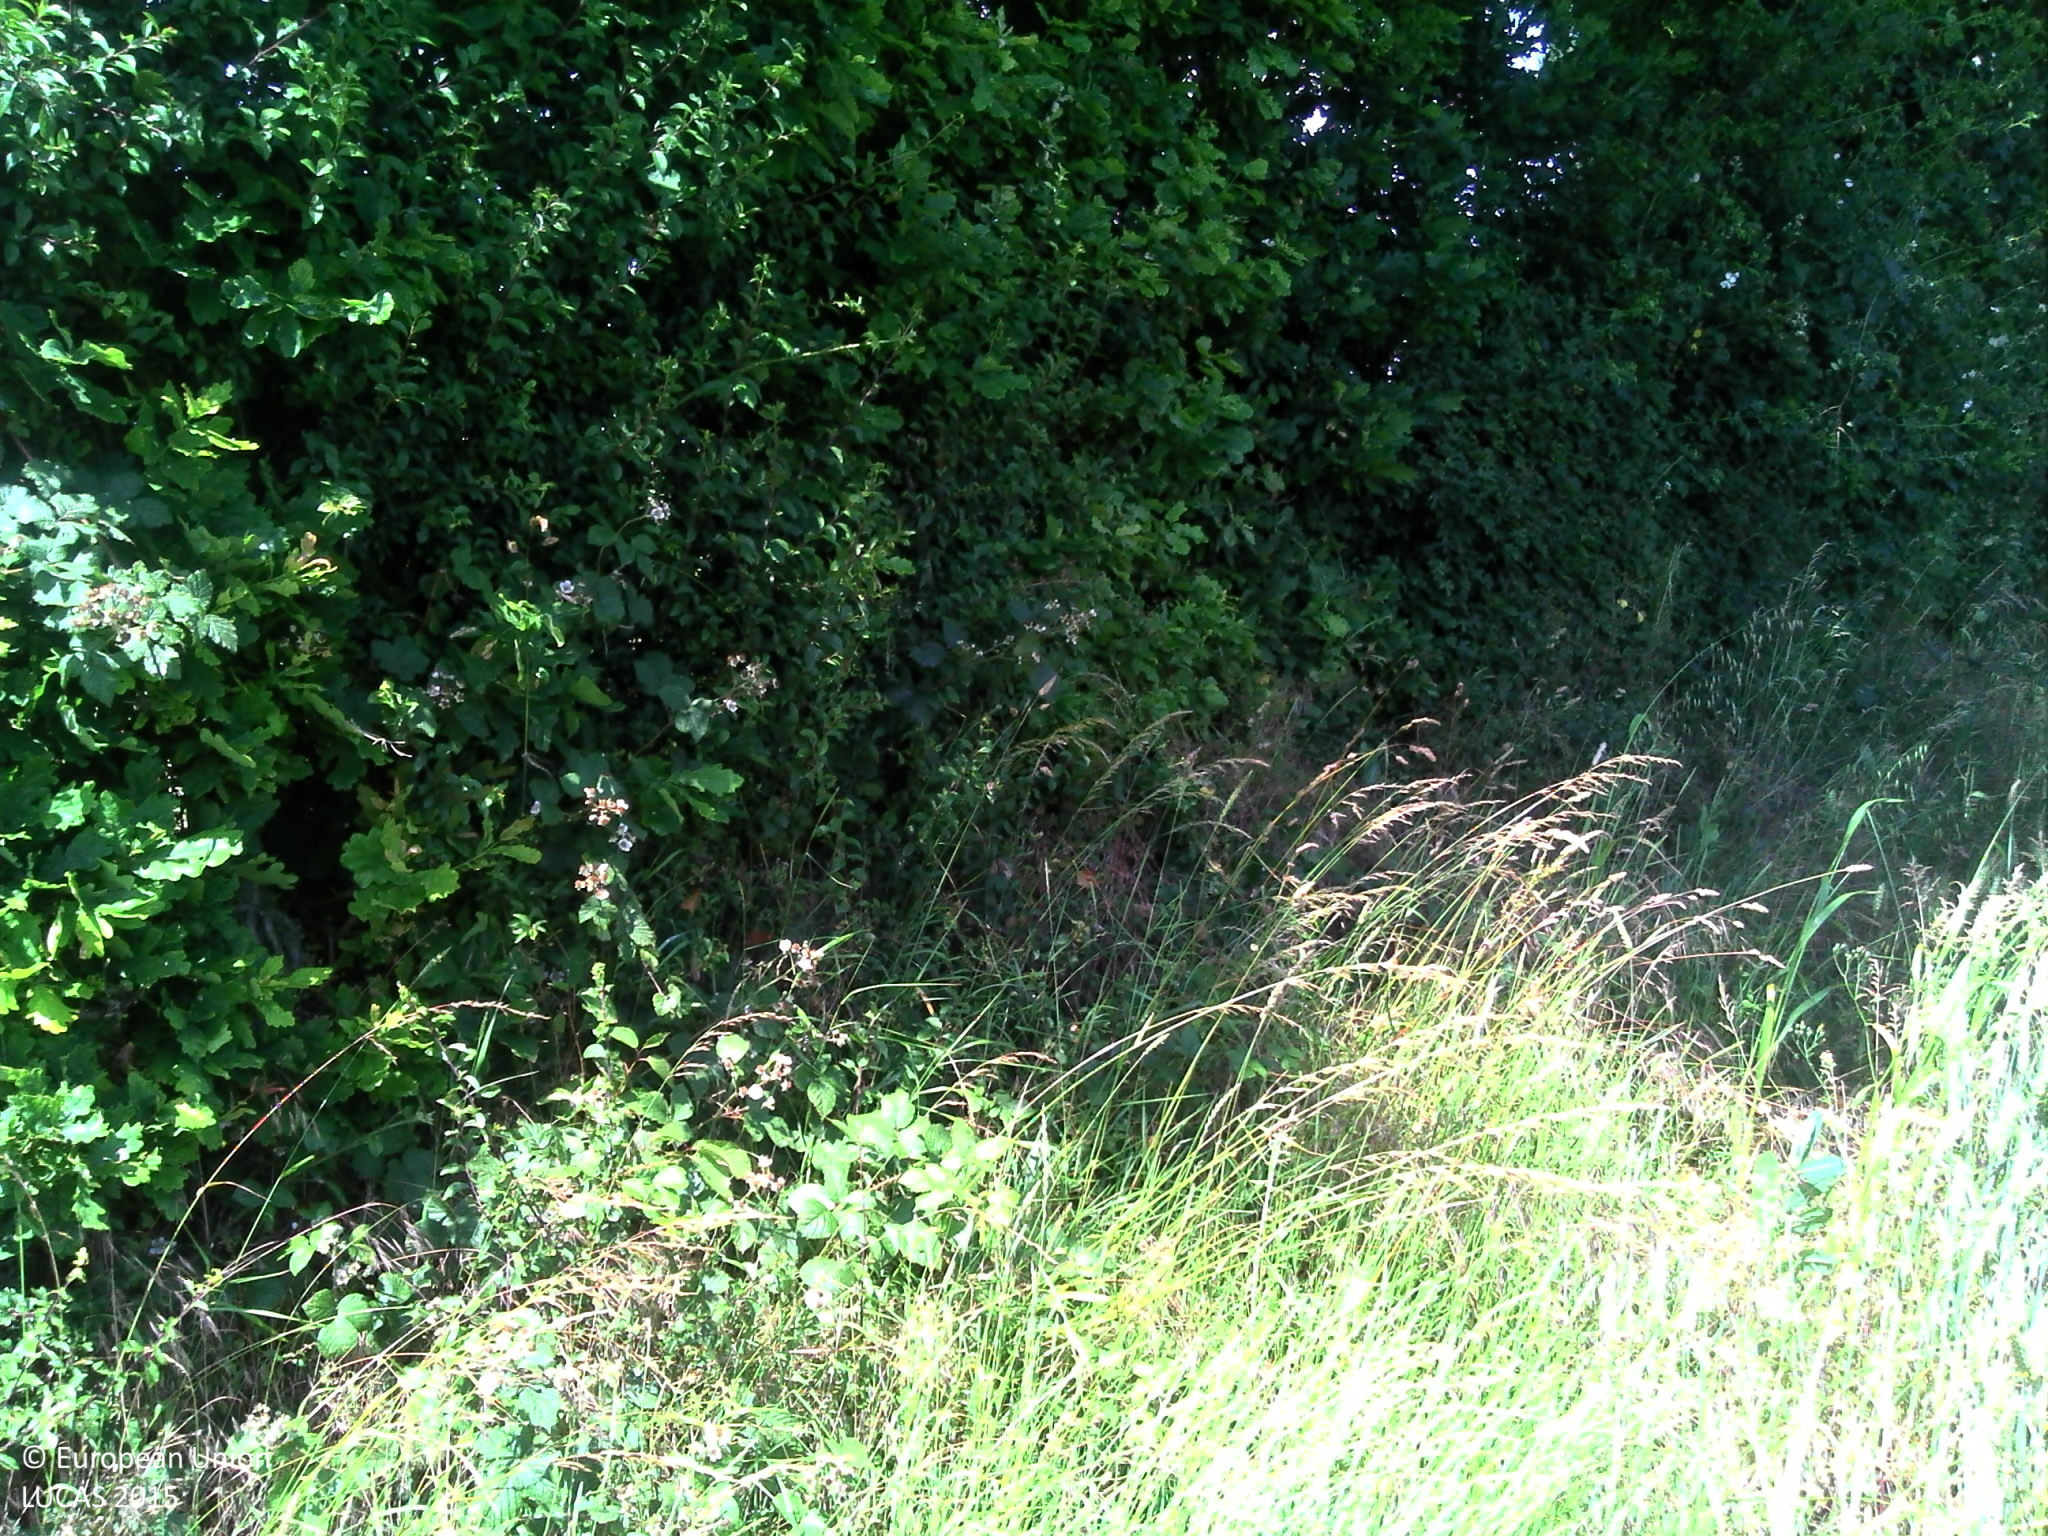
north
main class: Cropland
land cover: Common wheat
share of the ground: > 75 %
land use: Agriculture (excluding fallow land and kitchen gardens)
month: June
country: FR
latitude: 48.7627
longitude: -0.2221
